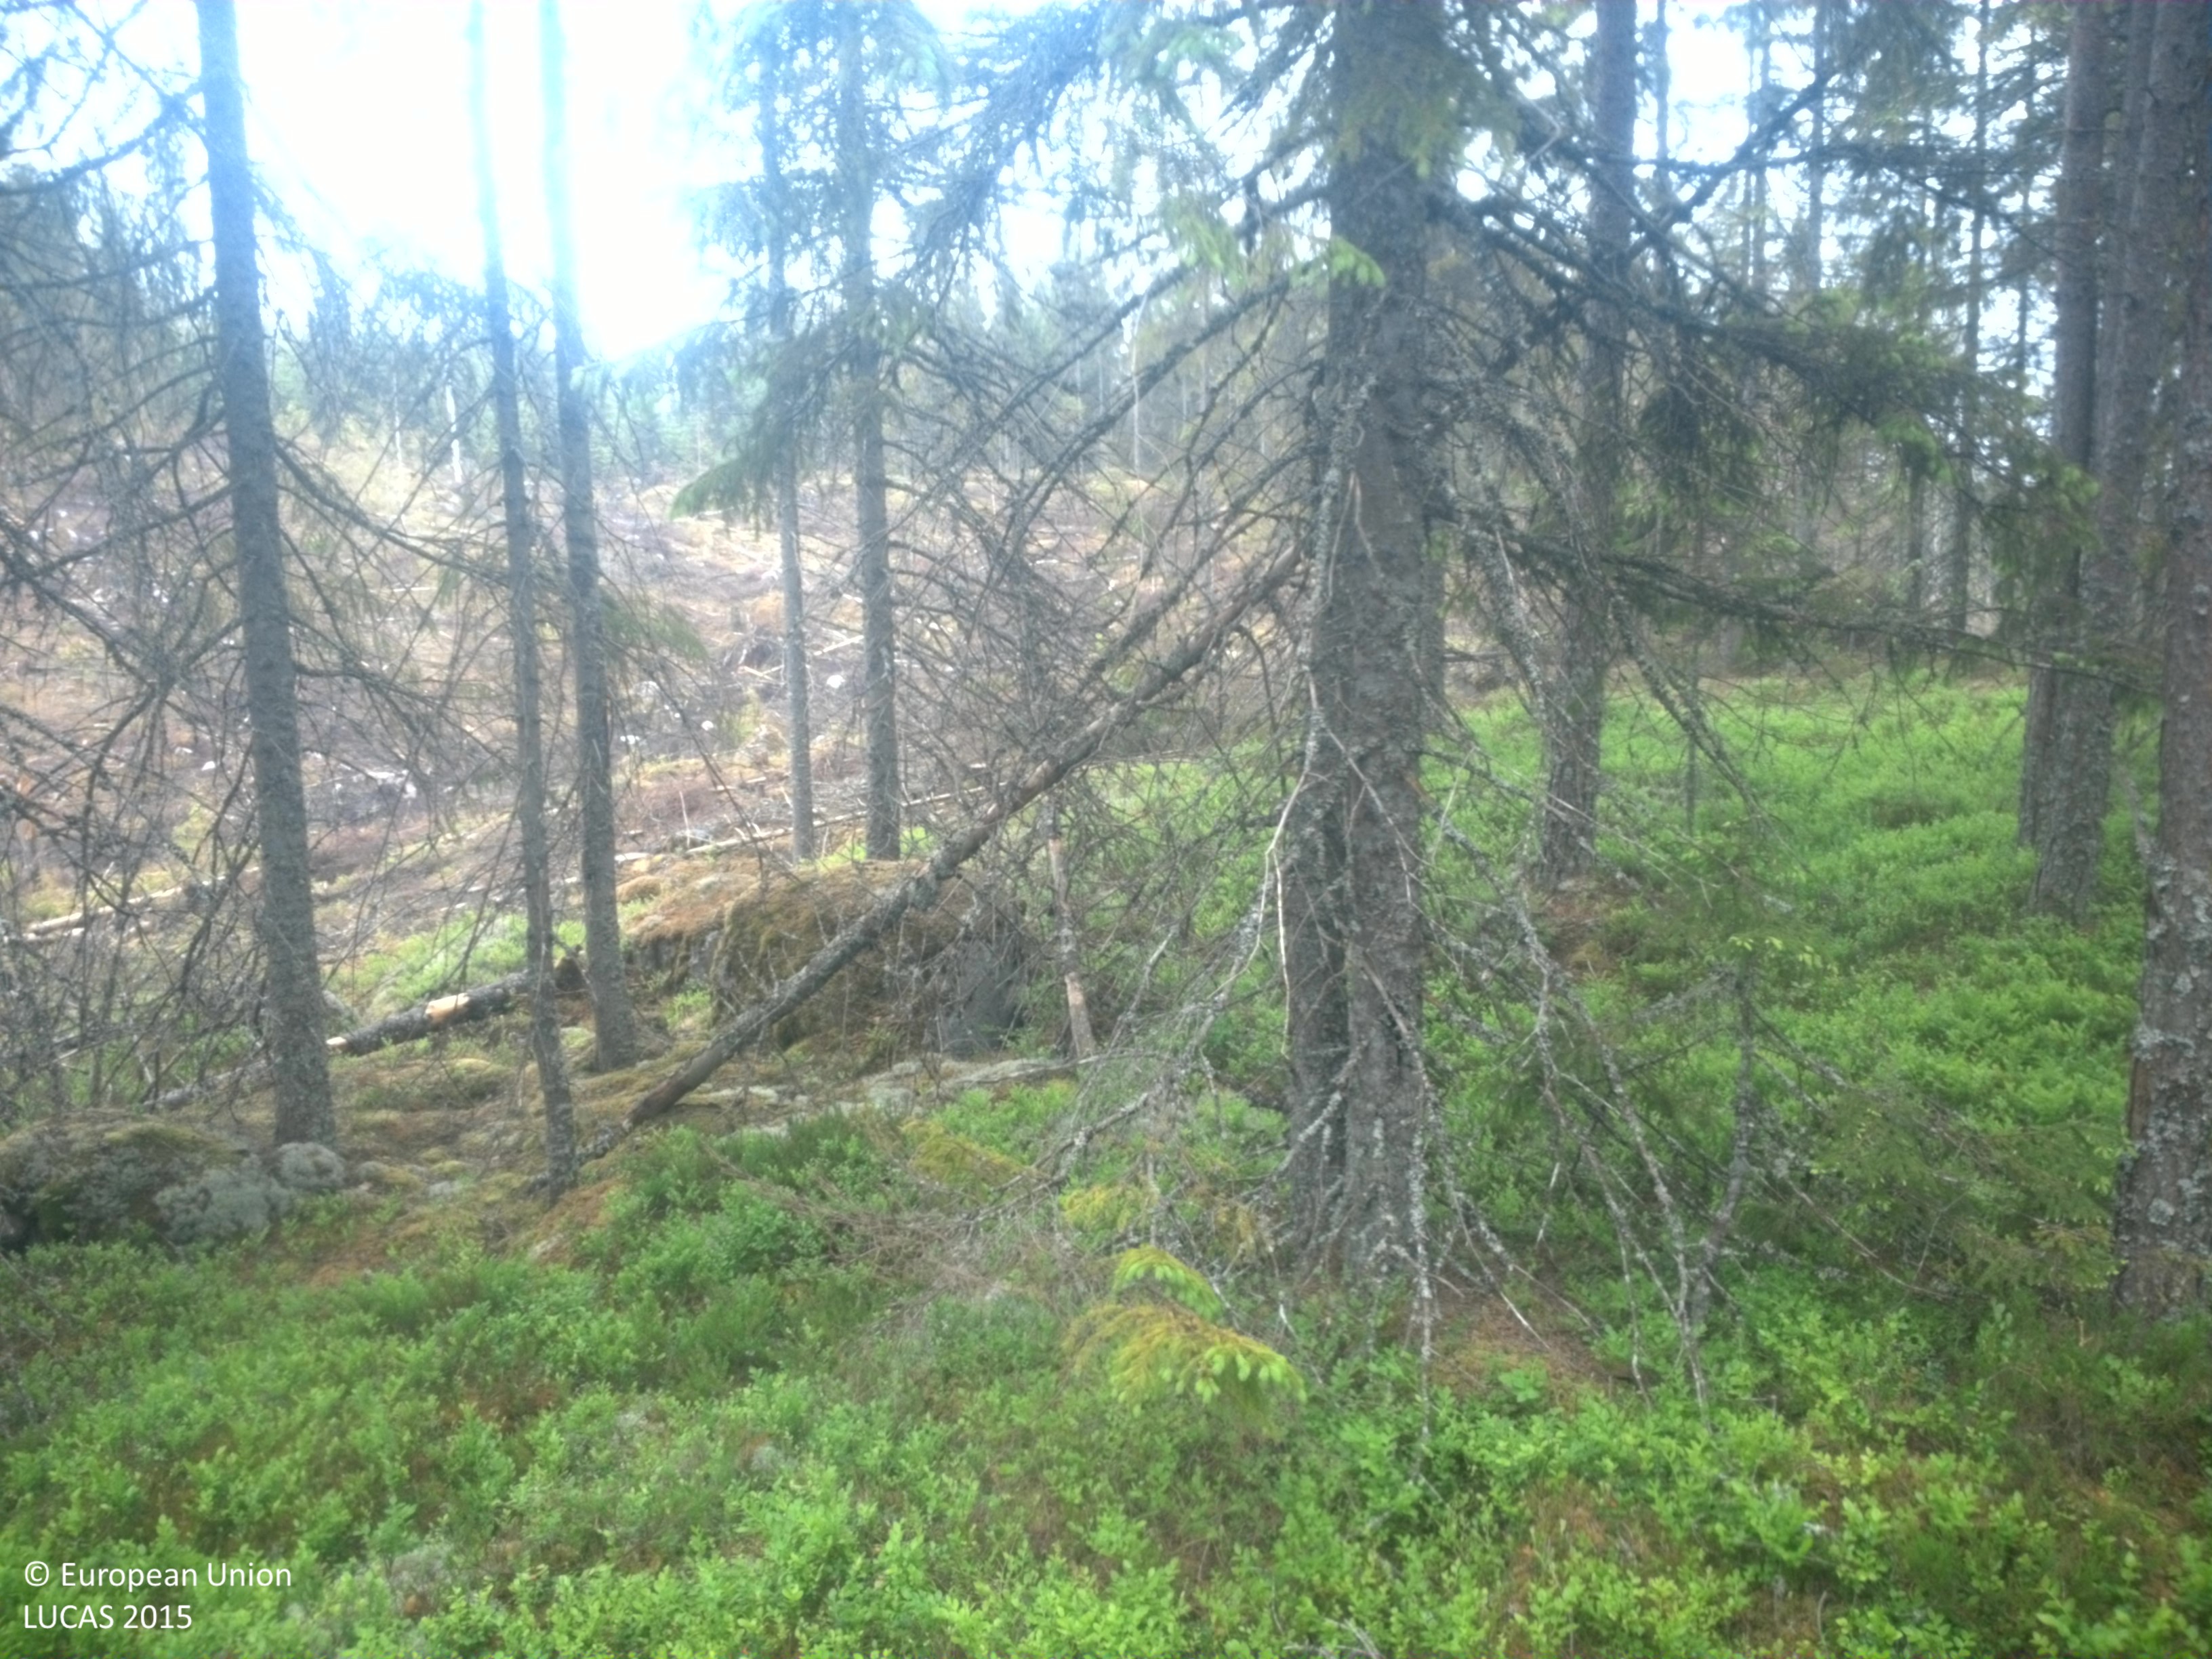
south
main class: Woodland
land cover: Other coniferous woodland
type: boreal forest
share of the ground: 50 - 75 %
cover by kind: coniferous forest trees 60 %, shrubs 20 %, herbaceous plants 10 %, lichens and mosses 5 %, consolidated bare surface 5 %
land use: Forestry
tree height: > 5 m
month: June
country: SE
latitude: 59.4815
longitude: 14.3871
